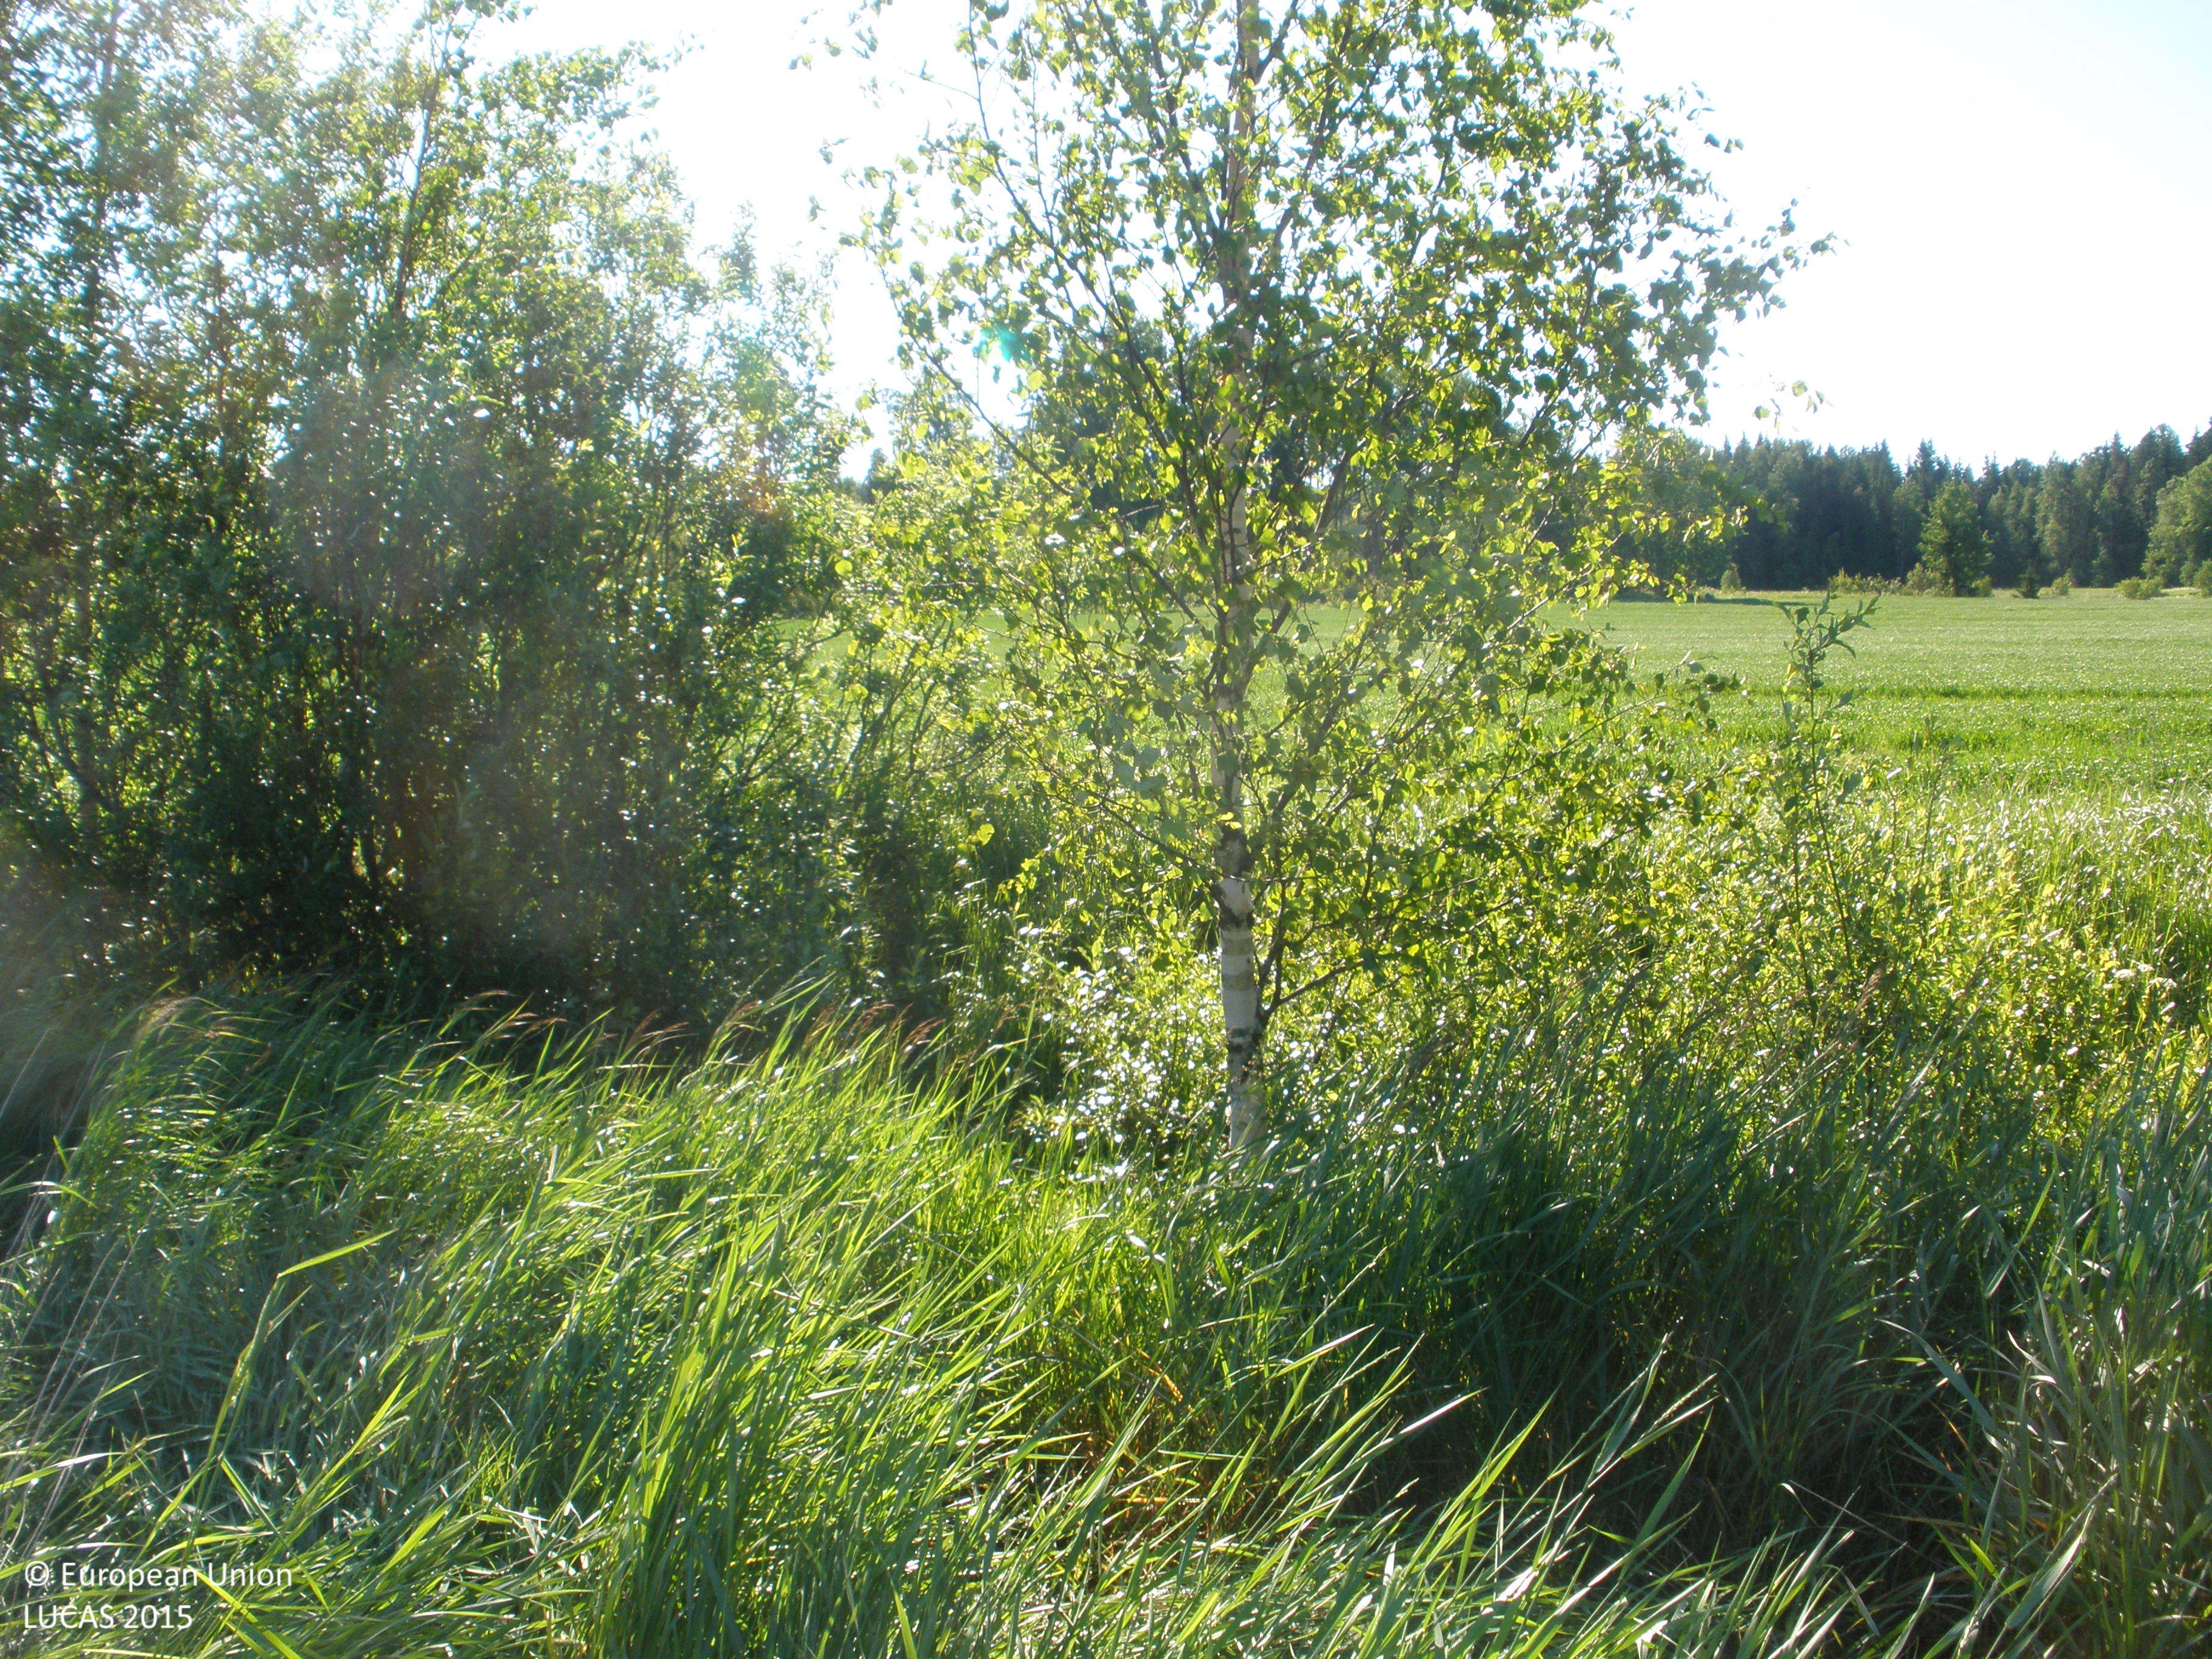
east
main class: Cropland
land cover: Mixed cereals for fodder
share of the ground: 25 - 50 %
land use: Agriculture (excluding fallow land and kitchen gardens)
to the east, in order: Mixed cereals for fodder; Grass margins; Ditches and canals; Abandoned hedges; Grass margins; Artificial constructions; Barley; Grass margins; Tracks; Grassland without tree/shrub cover
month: July
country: FI
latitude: 61.2302
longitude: 23.8903
